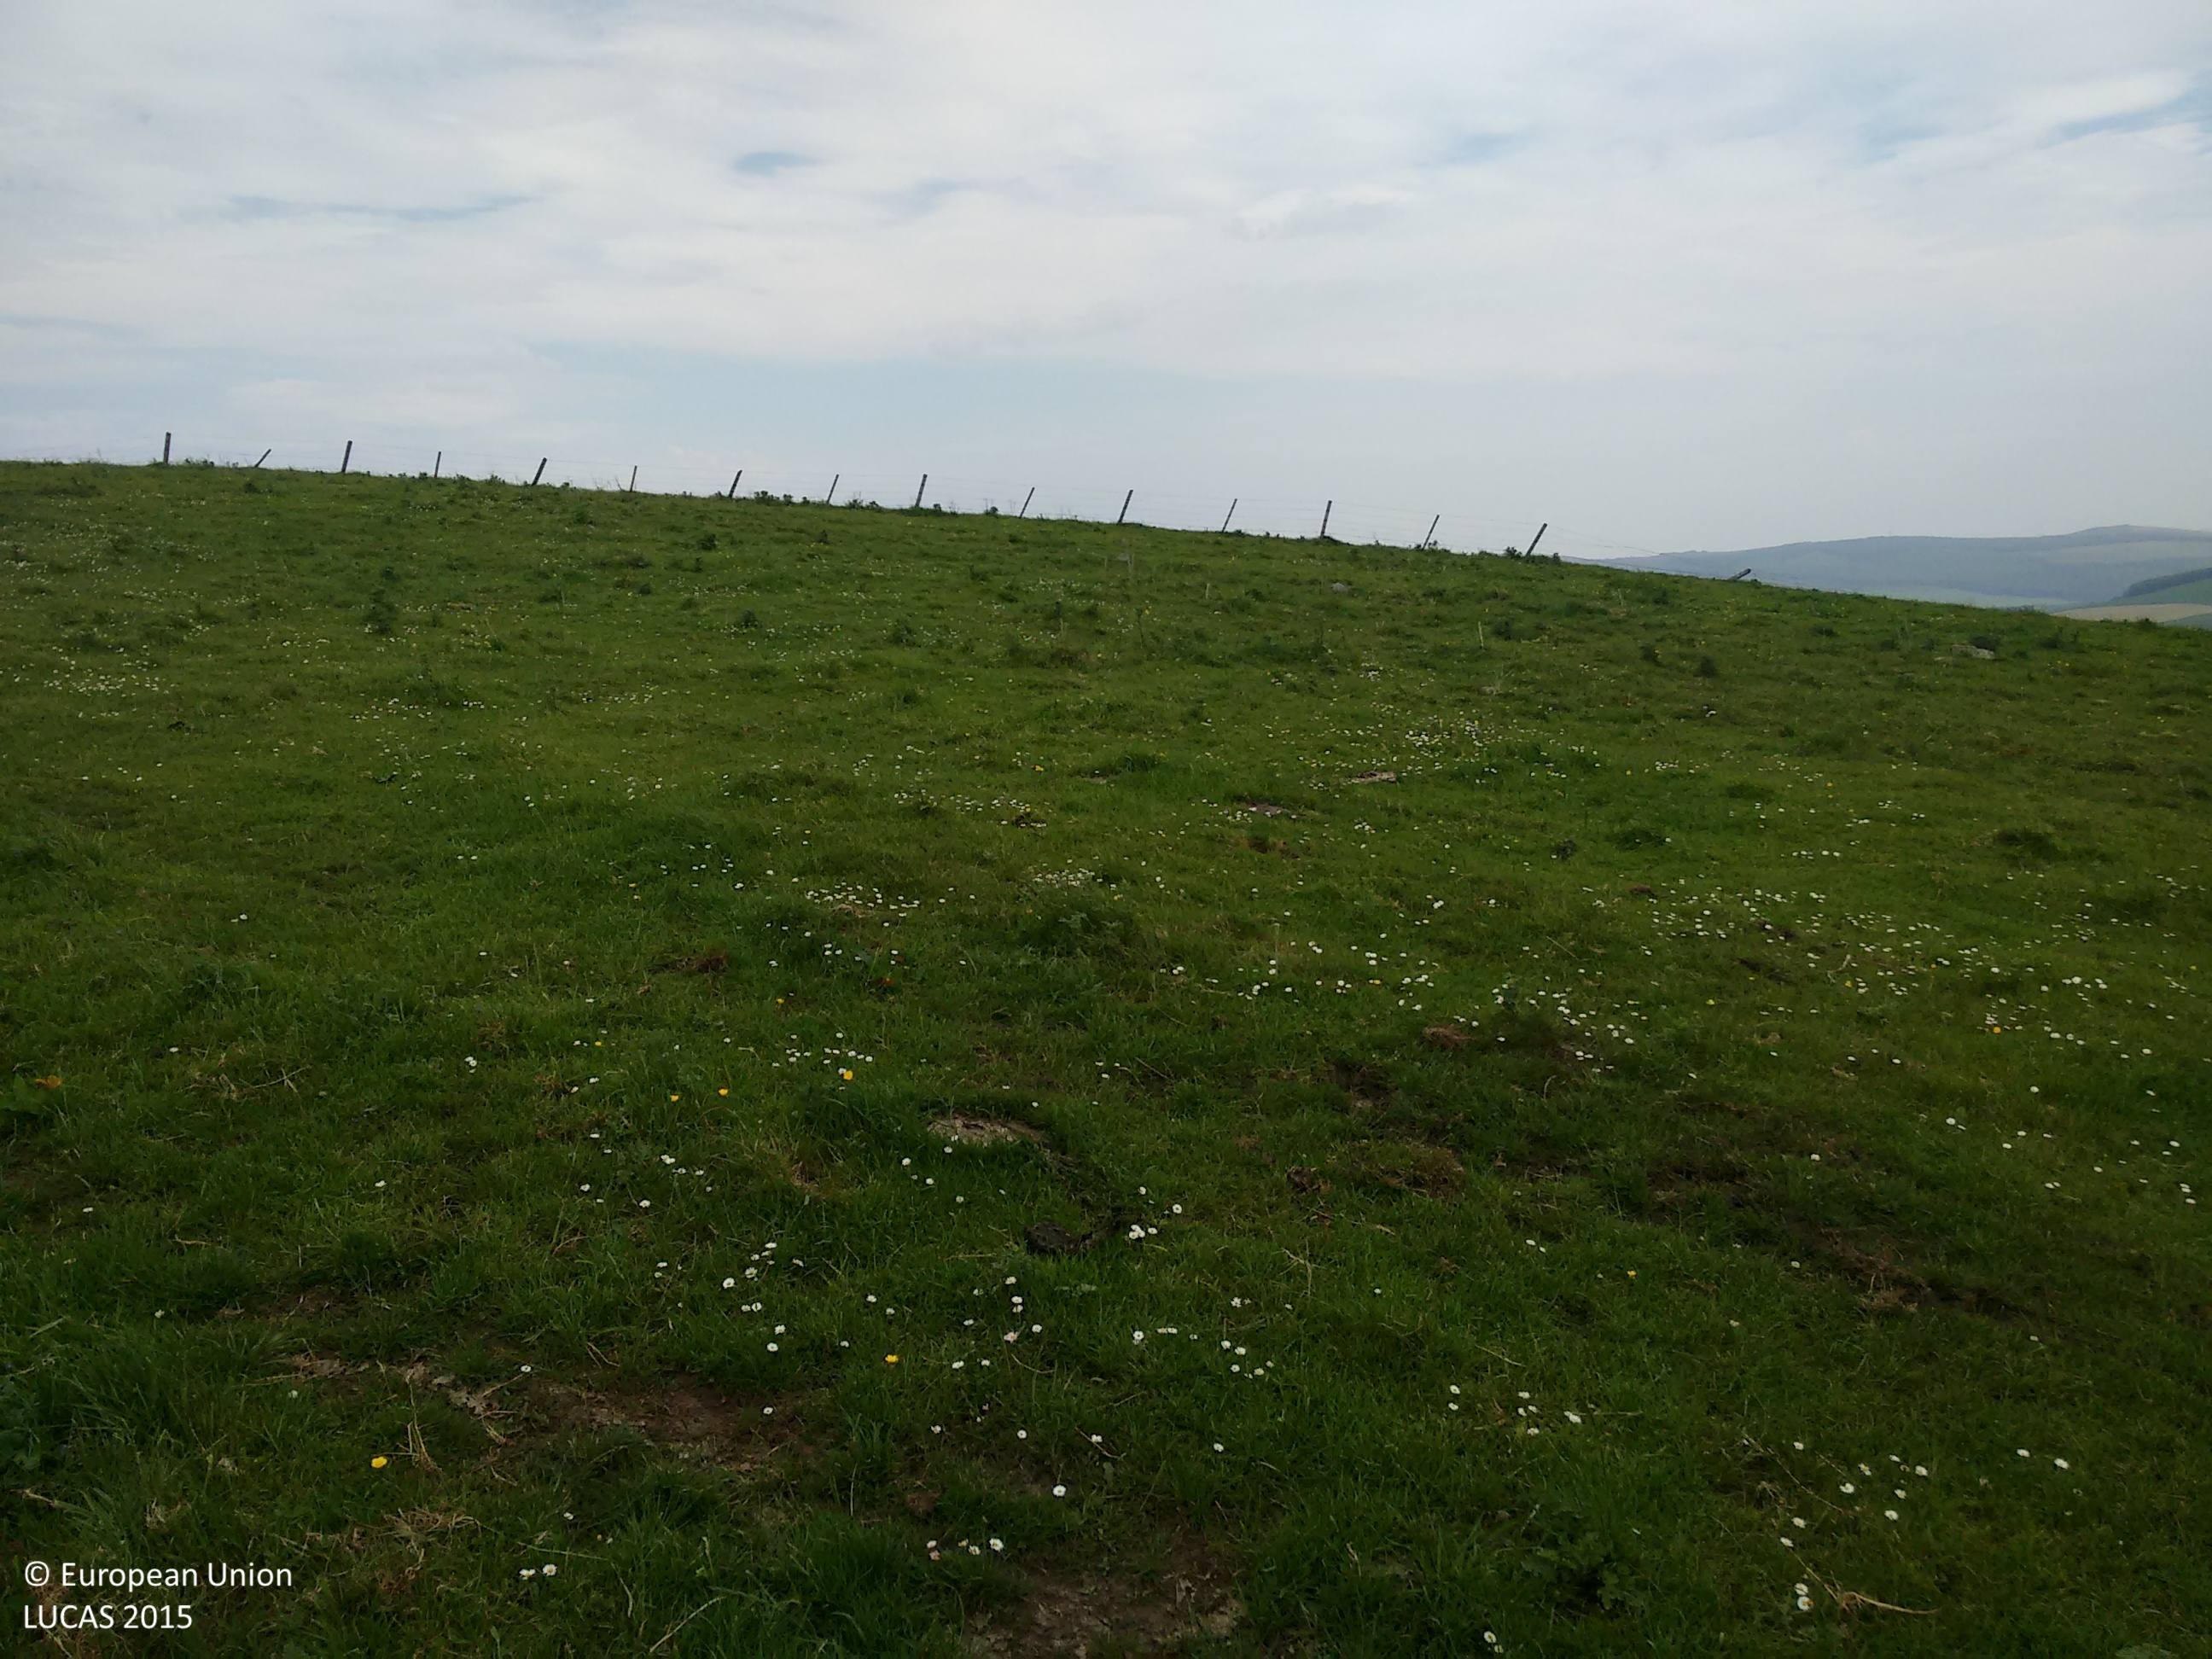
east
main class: Grassland
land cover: Grassland without tree/shrub cover
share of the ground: > 75 %
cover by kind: herbaceous plants 100 %
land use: Agriculture (excluding fallow land and kitchen gardens)
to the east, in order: Grassland without tree/shrub cover; Fences; Grassland without tree/shrub cover
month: July
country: GB
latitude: 57.4156
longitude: -2.8621
